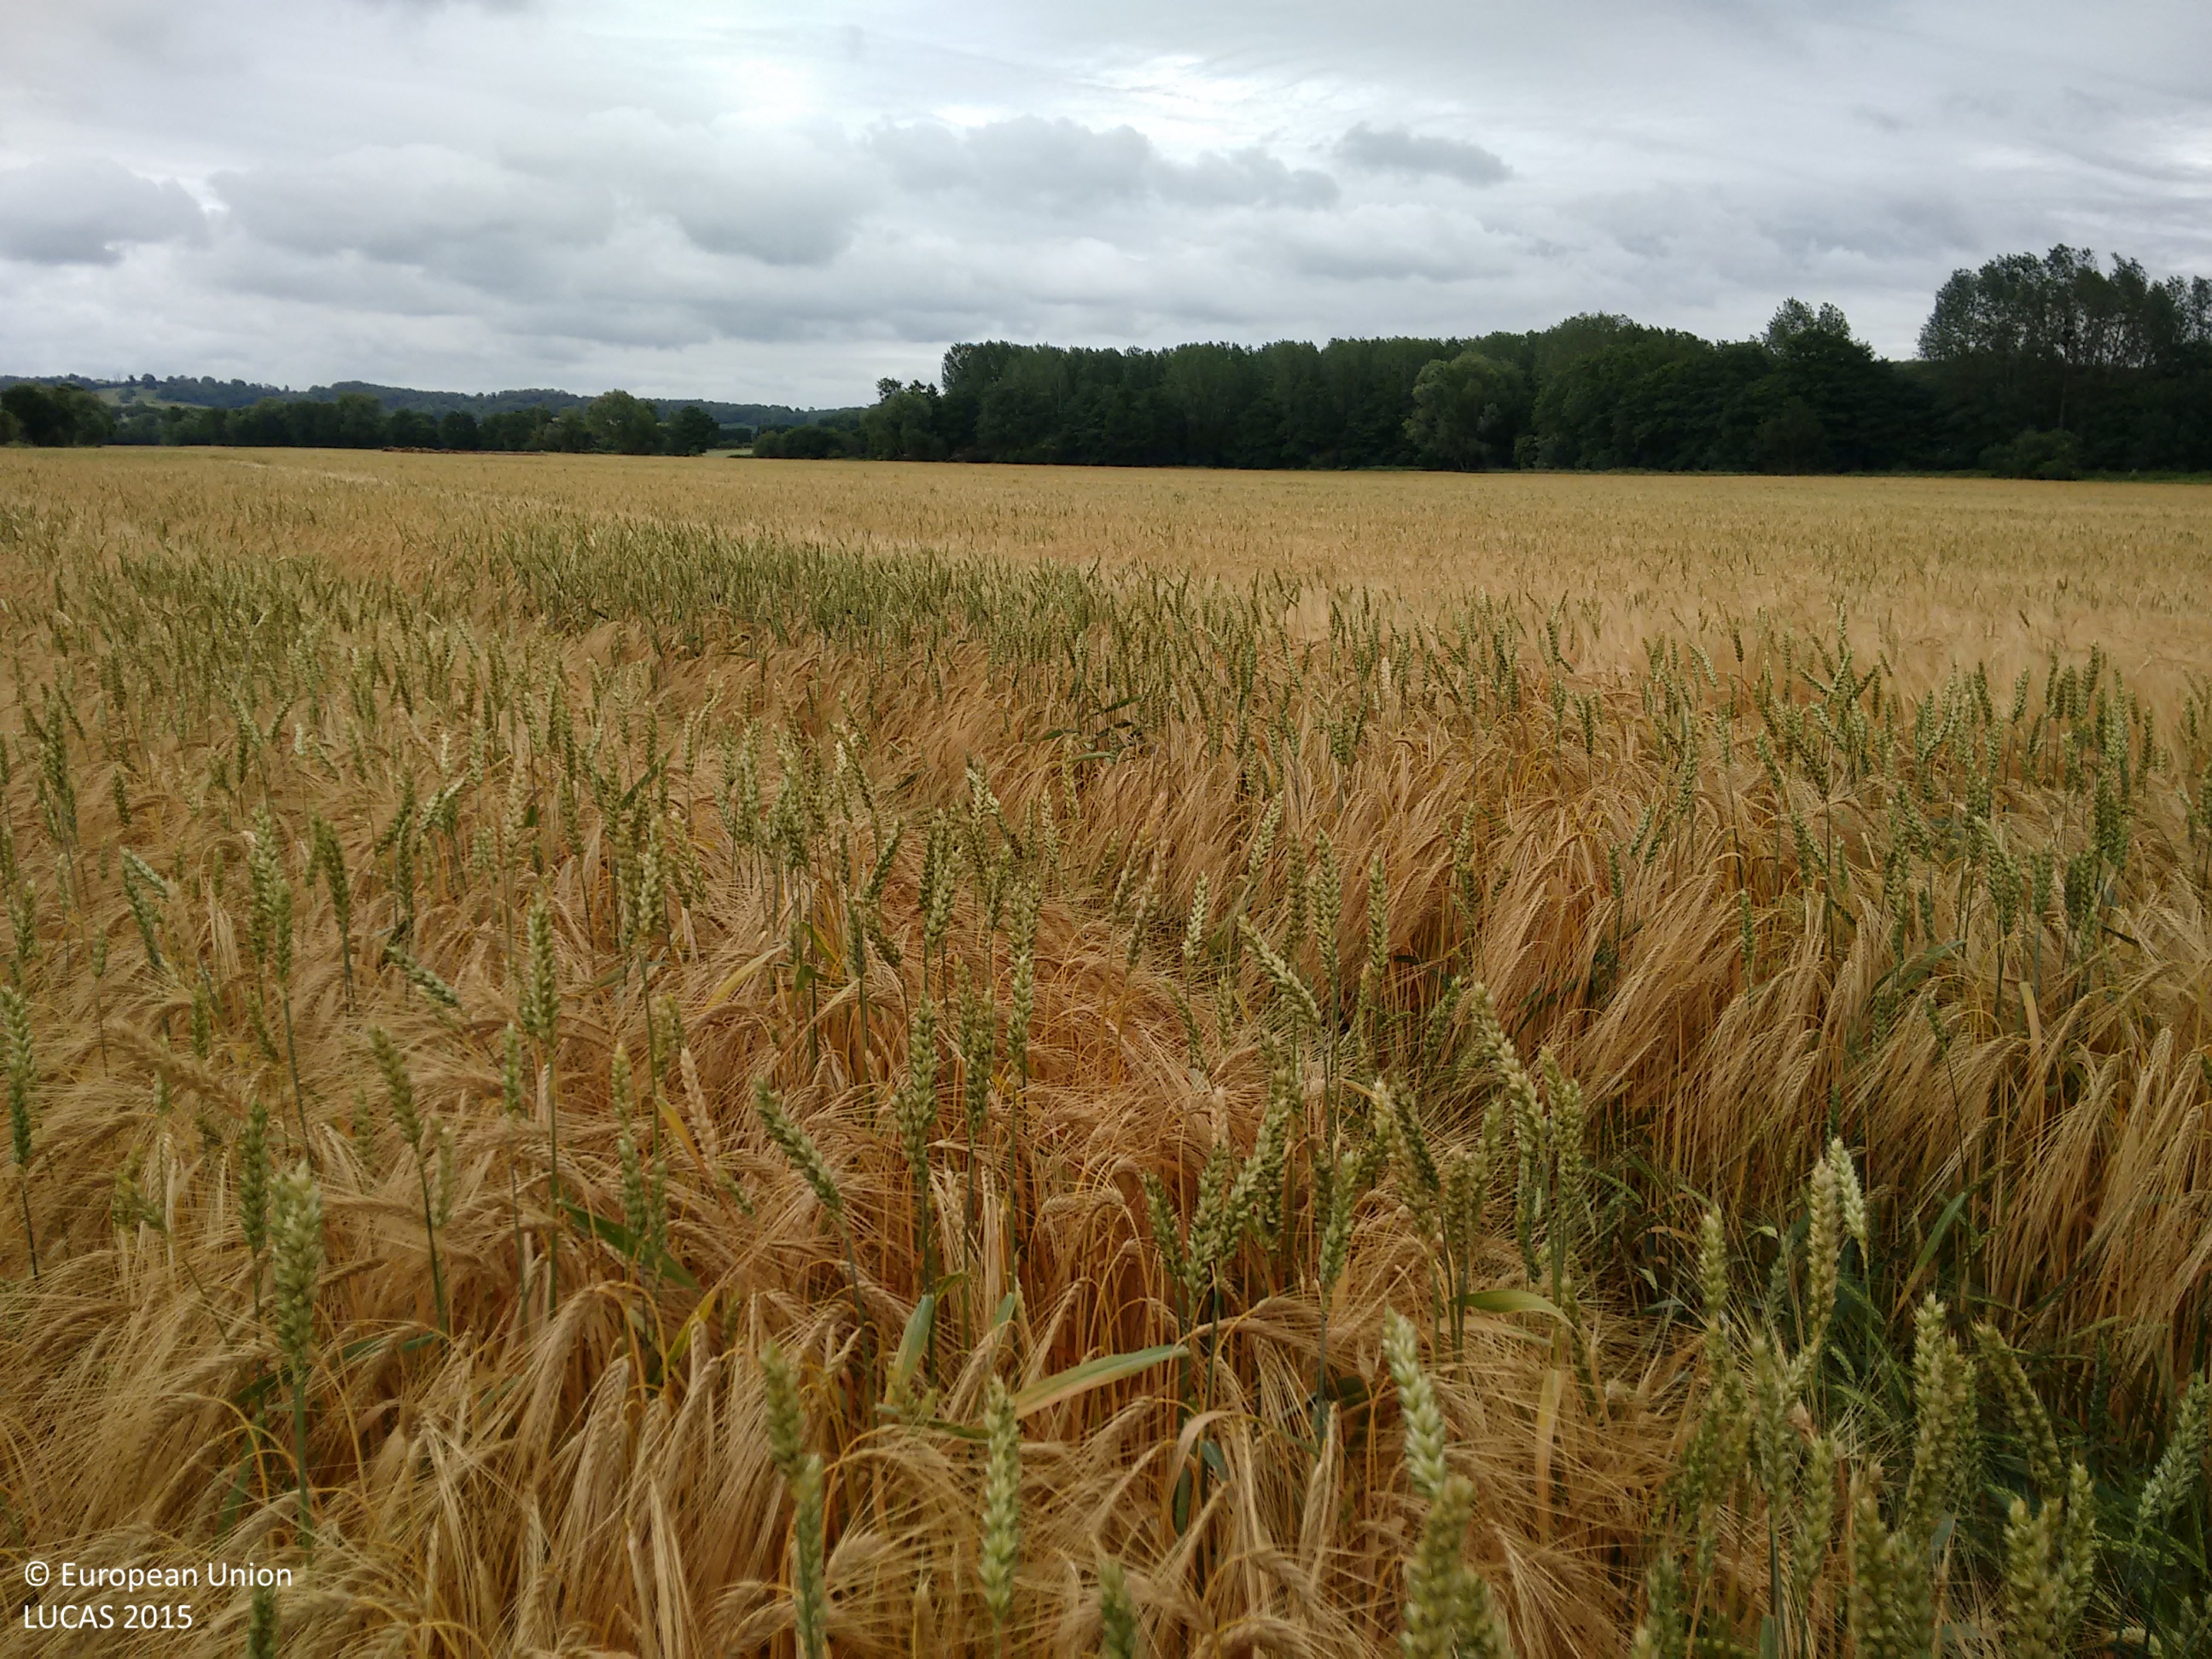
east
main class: Cropland
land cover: Barley
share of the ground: > 75 %
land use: Agriculture (excluding fallow land and kitchen gardens)
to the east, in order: Barley; Grass margins; Broadleaved woodland
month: July
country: GB
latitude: 52.0939
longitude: -2.5175
